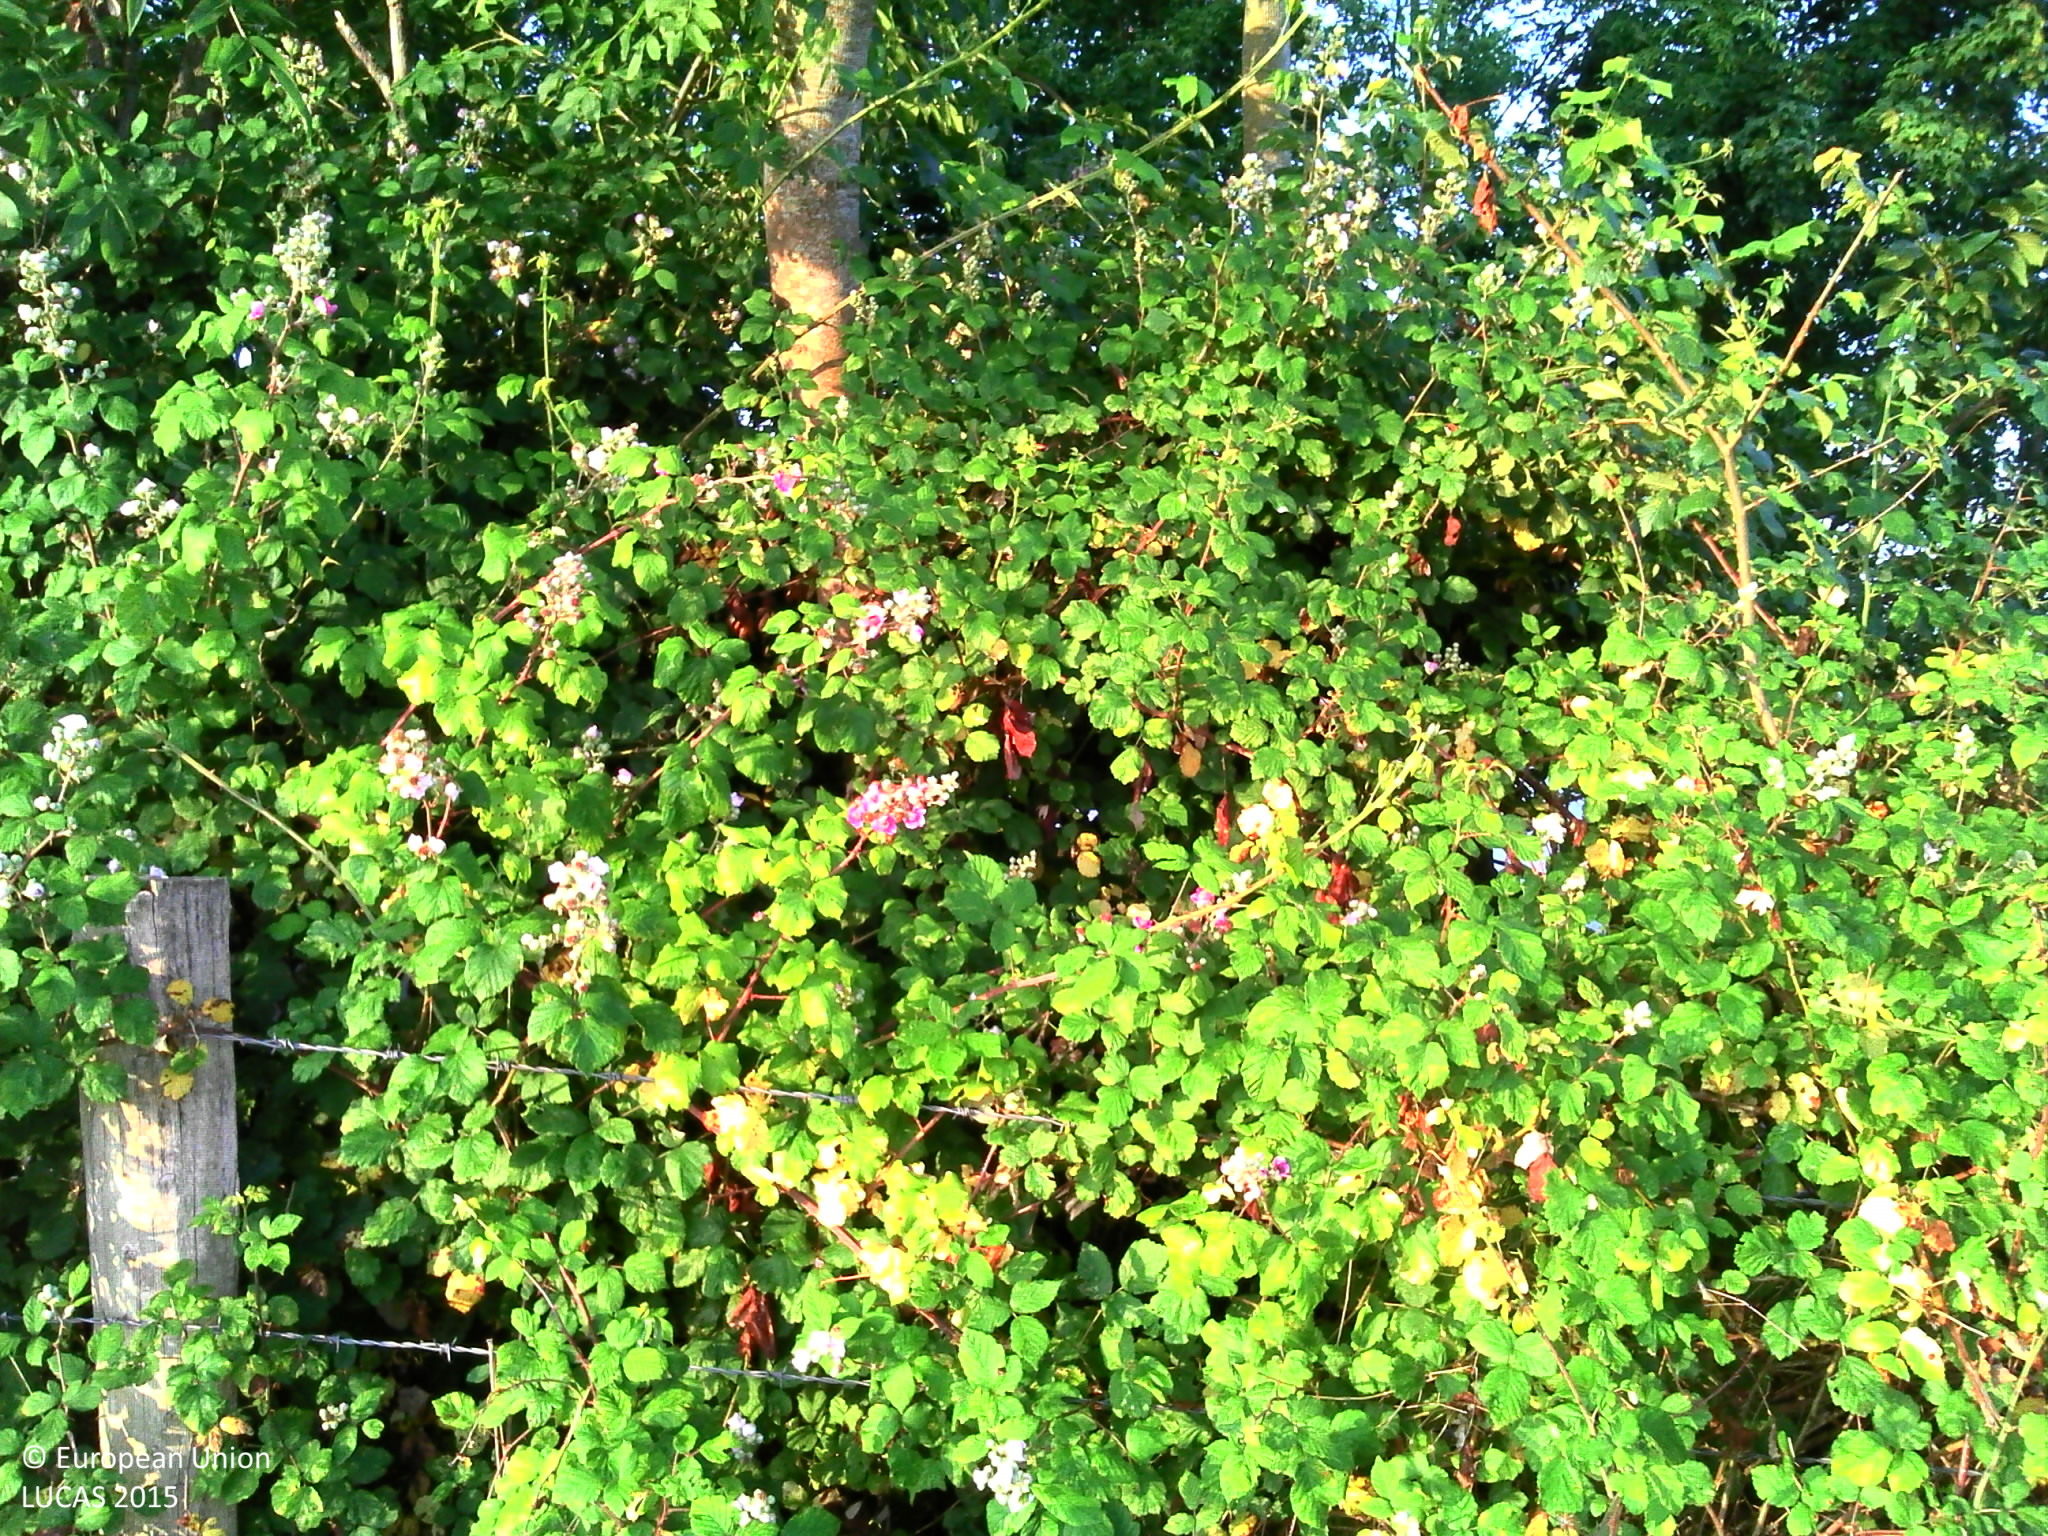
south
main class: Grassland
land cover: Grassland without tree/shrub cover
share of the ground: > 75 %
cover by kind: herbaceous plants 100 %
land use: Agriculture (excluding fallow land and kitchen gardens)
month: July
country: FR
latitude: 49.0947
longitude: 0.0407
